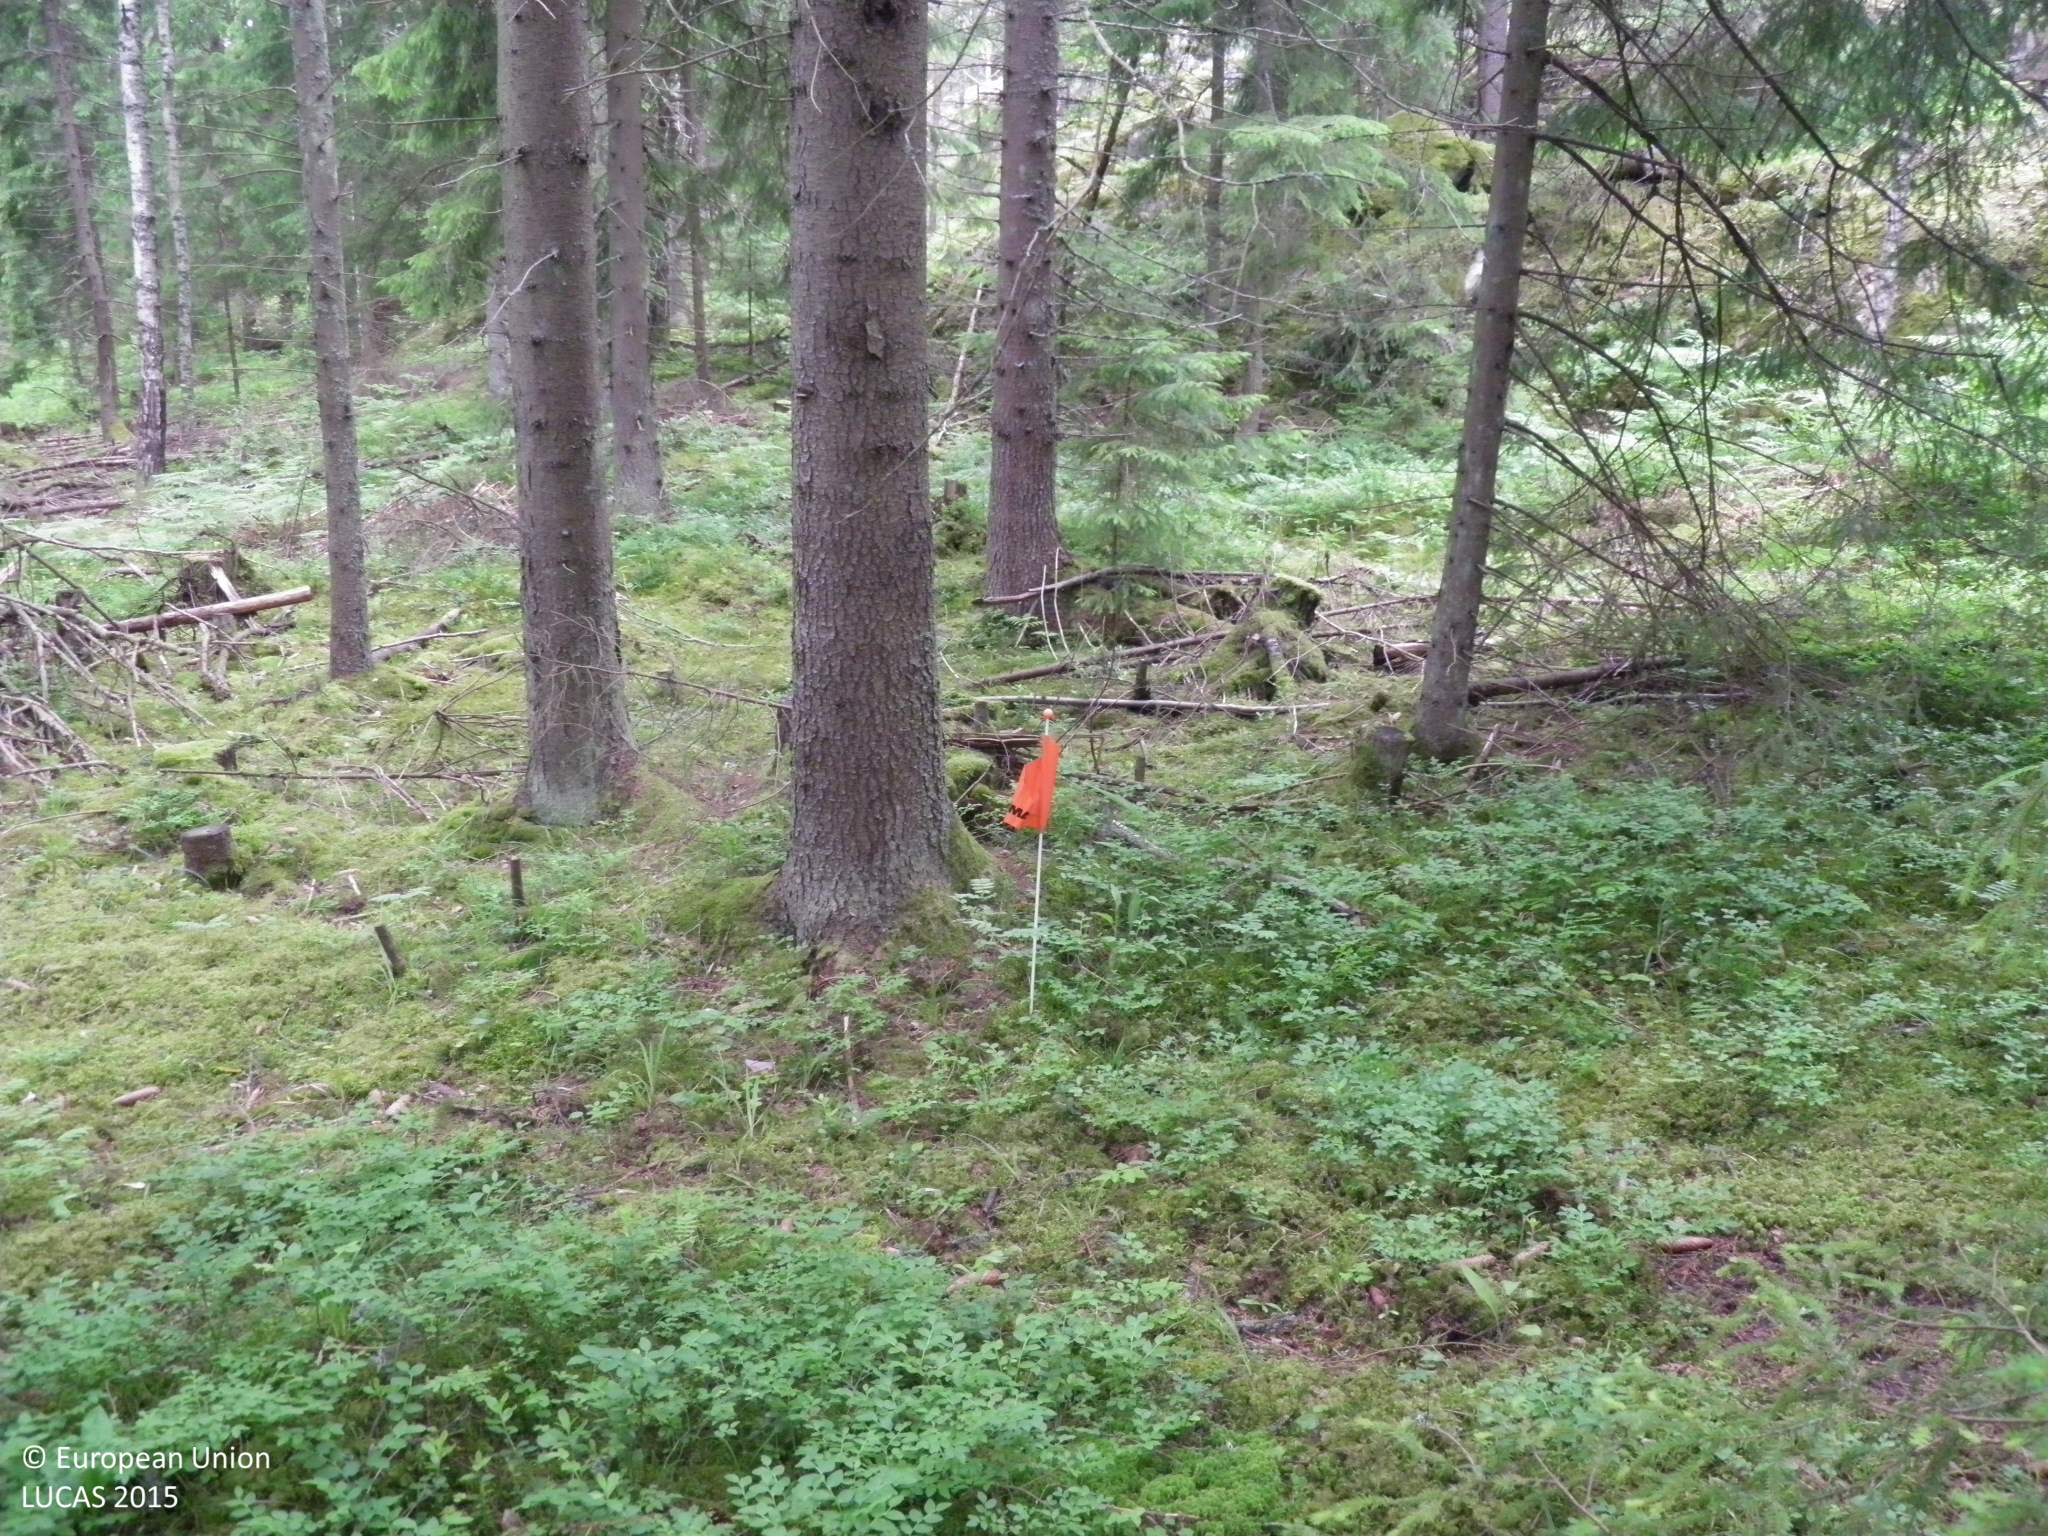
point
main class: Woodland
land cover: Spruce dominated coniferous woodland
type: hemiboreal forest and nemoral coniferous forest and mixed broadleaved-coniferous forest
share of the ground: > 75 %
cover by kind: coniferous forest trees 70 %, broadleaved forest trees 10 %, herbaceous plants 10 %, shrubs 5 %, lichens and mosses 5 %
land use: Forestry
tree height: > 5 m
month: June
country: FI
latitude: 60.2725
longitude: 22.1616
